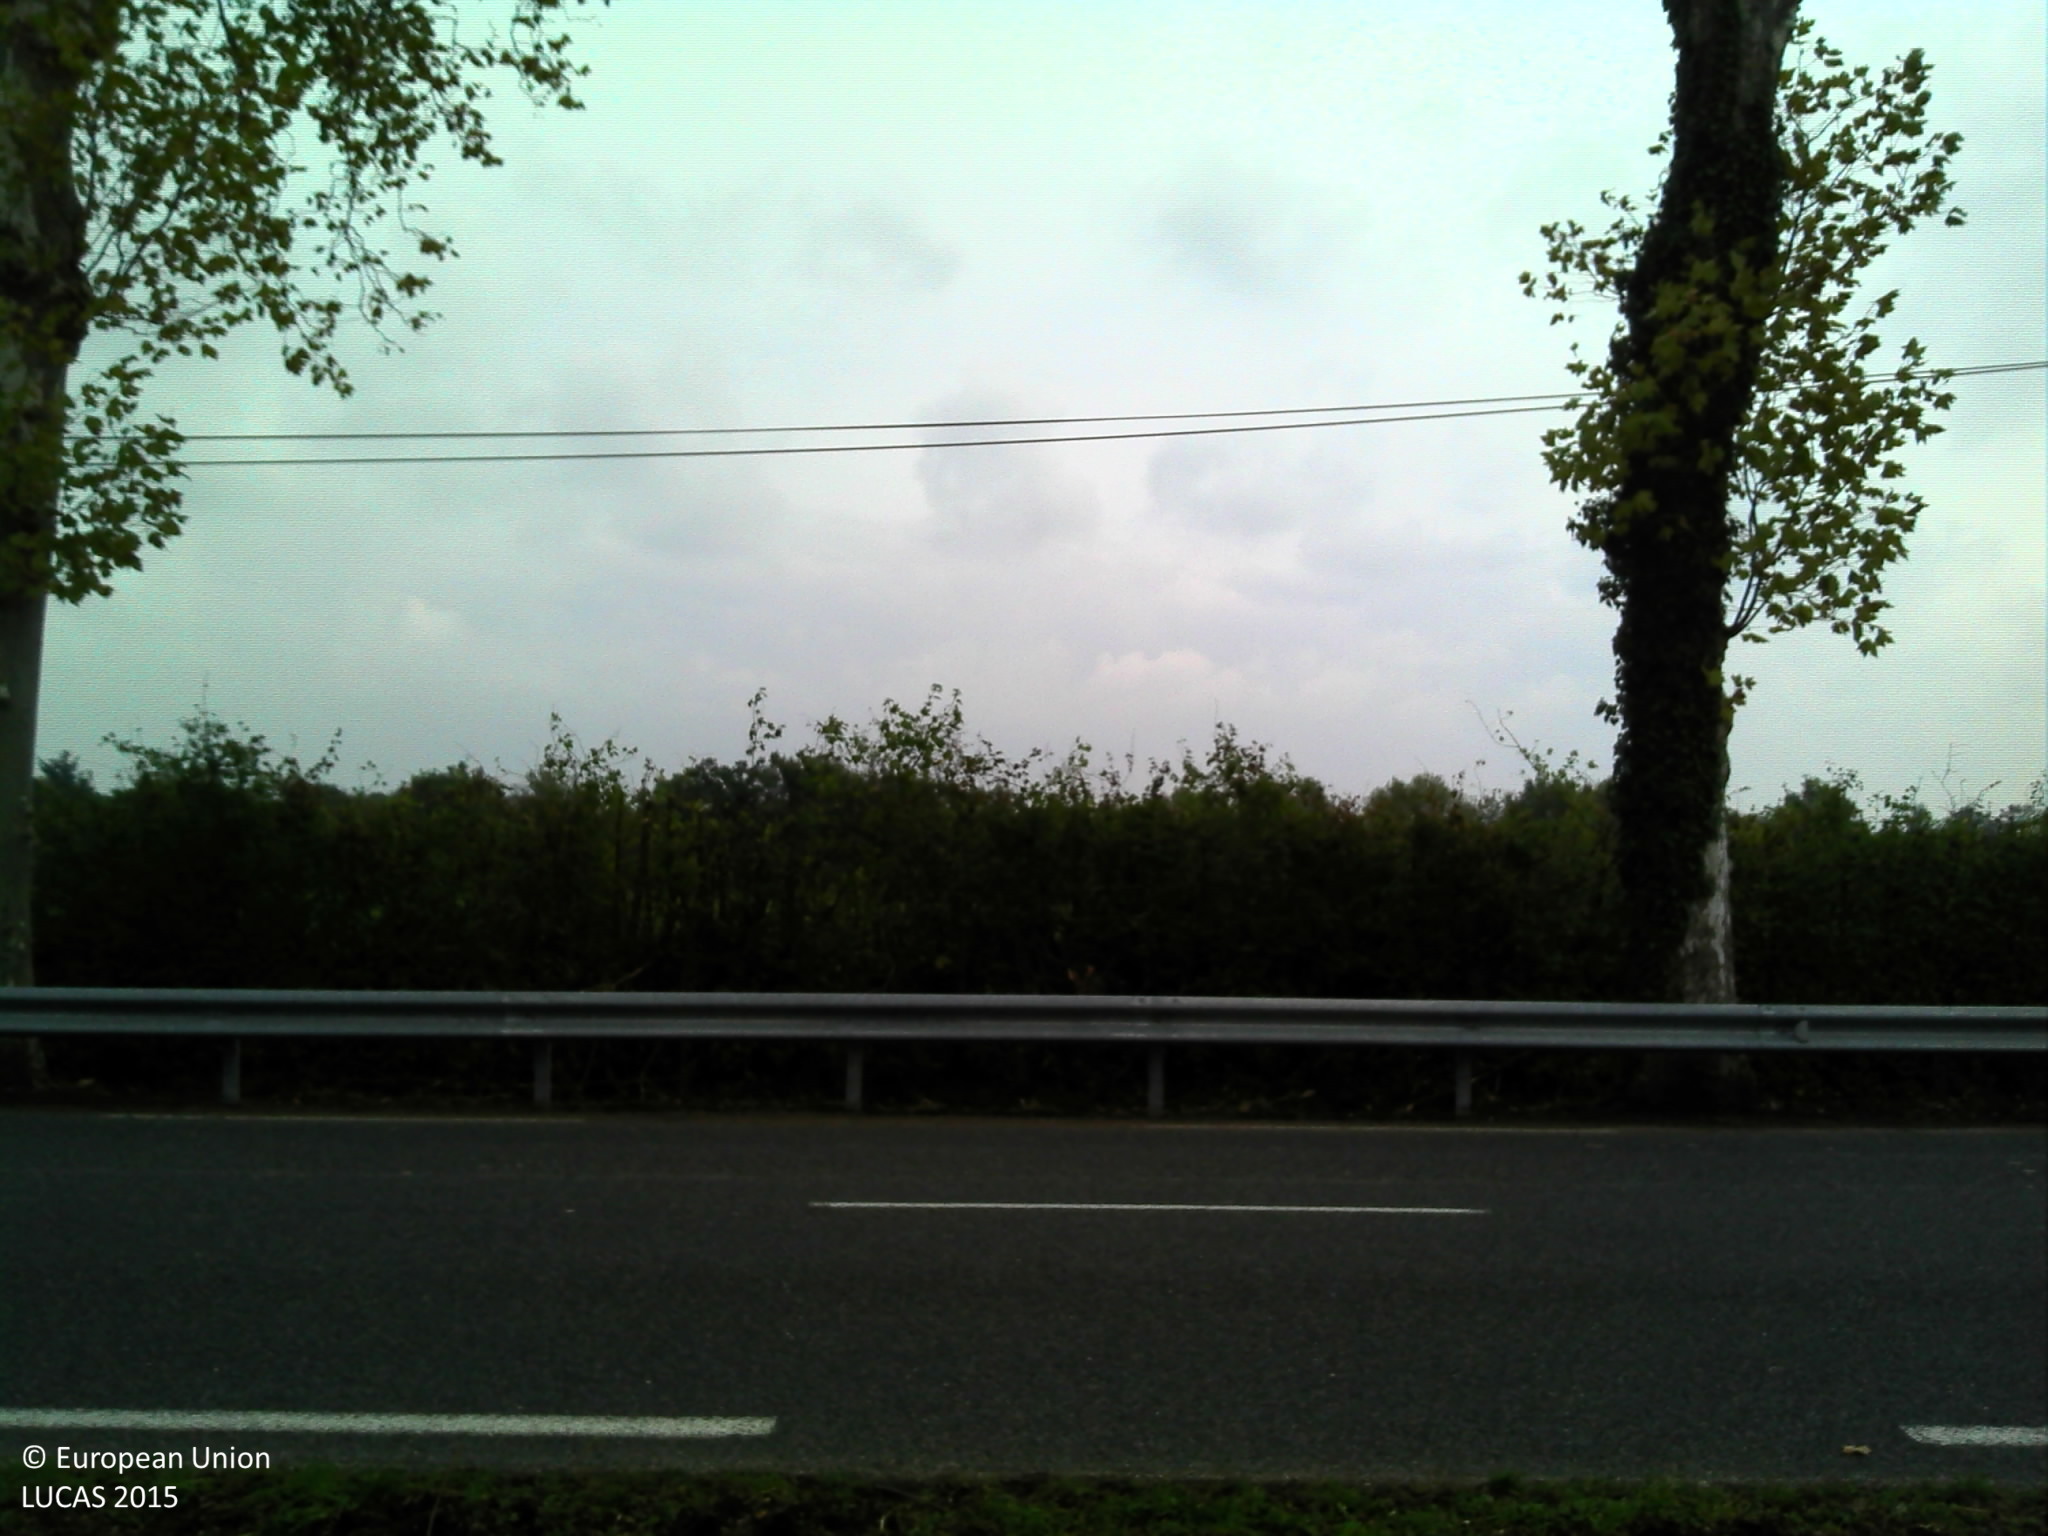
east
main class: Grassland
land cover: Grassland without tree/shrub cover
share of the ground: > 75 %
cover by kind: herbaceous plants 100 %
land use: Agriculture (excluding fallow land and kitchen gardens)
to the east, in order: Grassland without tree/shrub cover; Tracks; Grassland without tree/shrub cover; Fences; Abandoned hedges; Grass margins; Ditches and canals; Grass margins; Paved roads, cycling and walking lanes; Lines of trees; Ditches and canals; Electric lines; Abandoned hedges; Fences; Grassland without tree/shrub cover; Fences; Grassland without tree/shrub cover; Abandoned hedges; Ditches and canals; Other bare soil
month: October
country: FR
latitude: 46.0670
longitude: 4.8963
